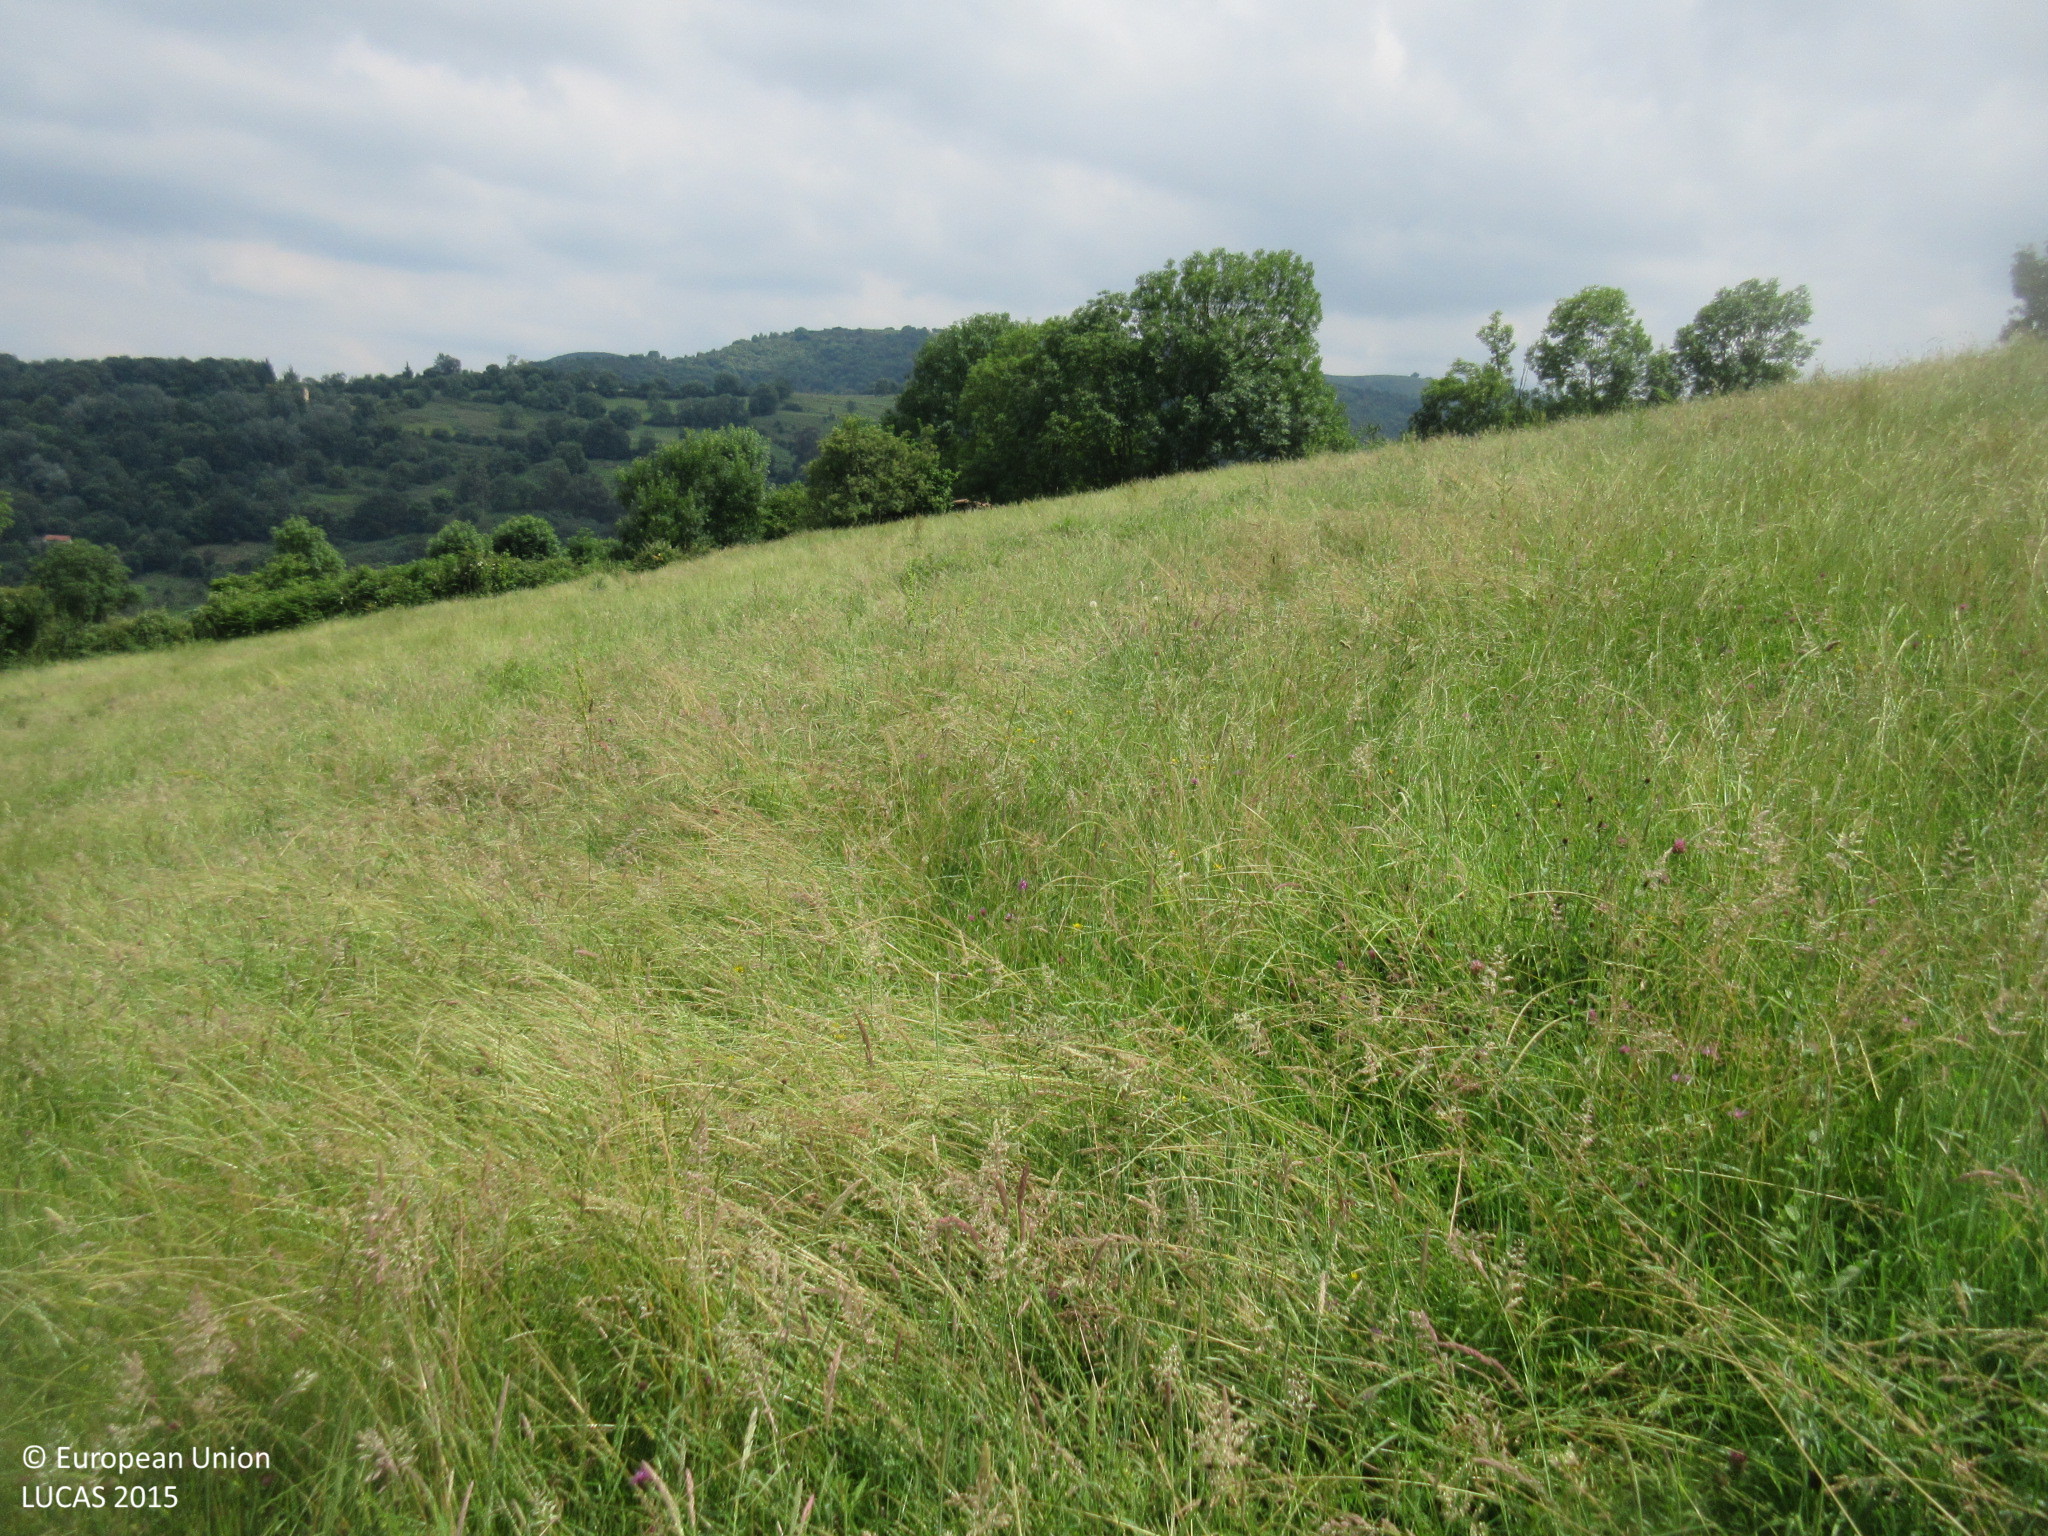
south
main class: Grassland
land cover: Grassland without tree/shrub cover
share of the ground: > 75 %
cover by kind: herbaceous plants 100 %
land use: Agriculture (excluding fallow land and kitchen gardens)
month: June
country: ES
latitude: 43.3396
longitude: -5.9903
